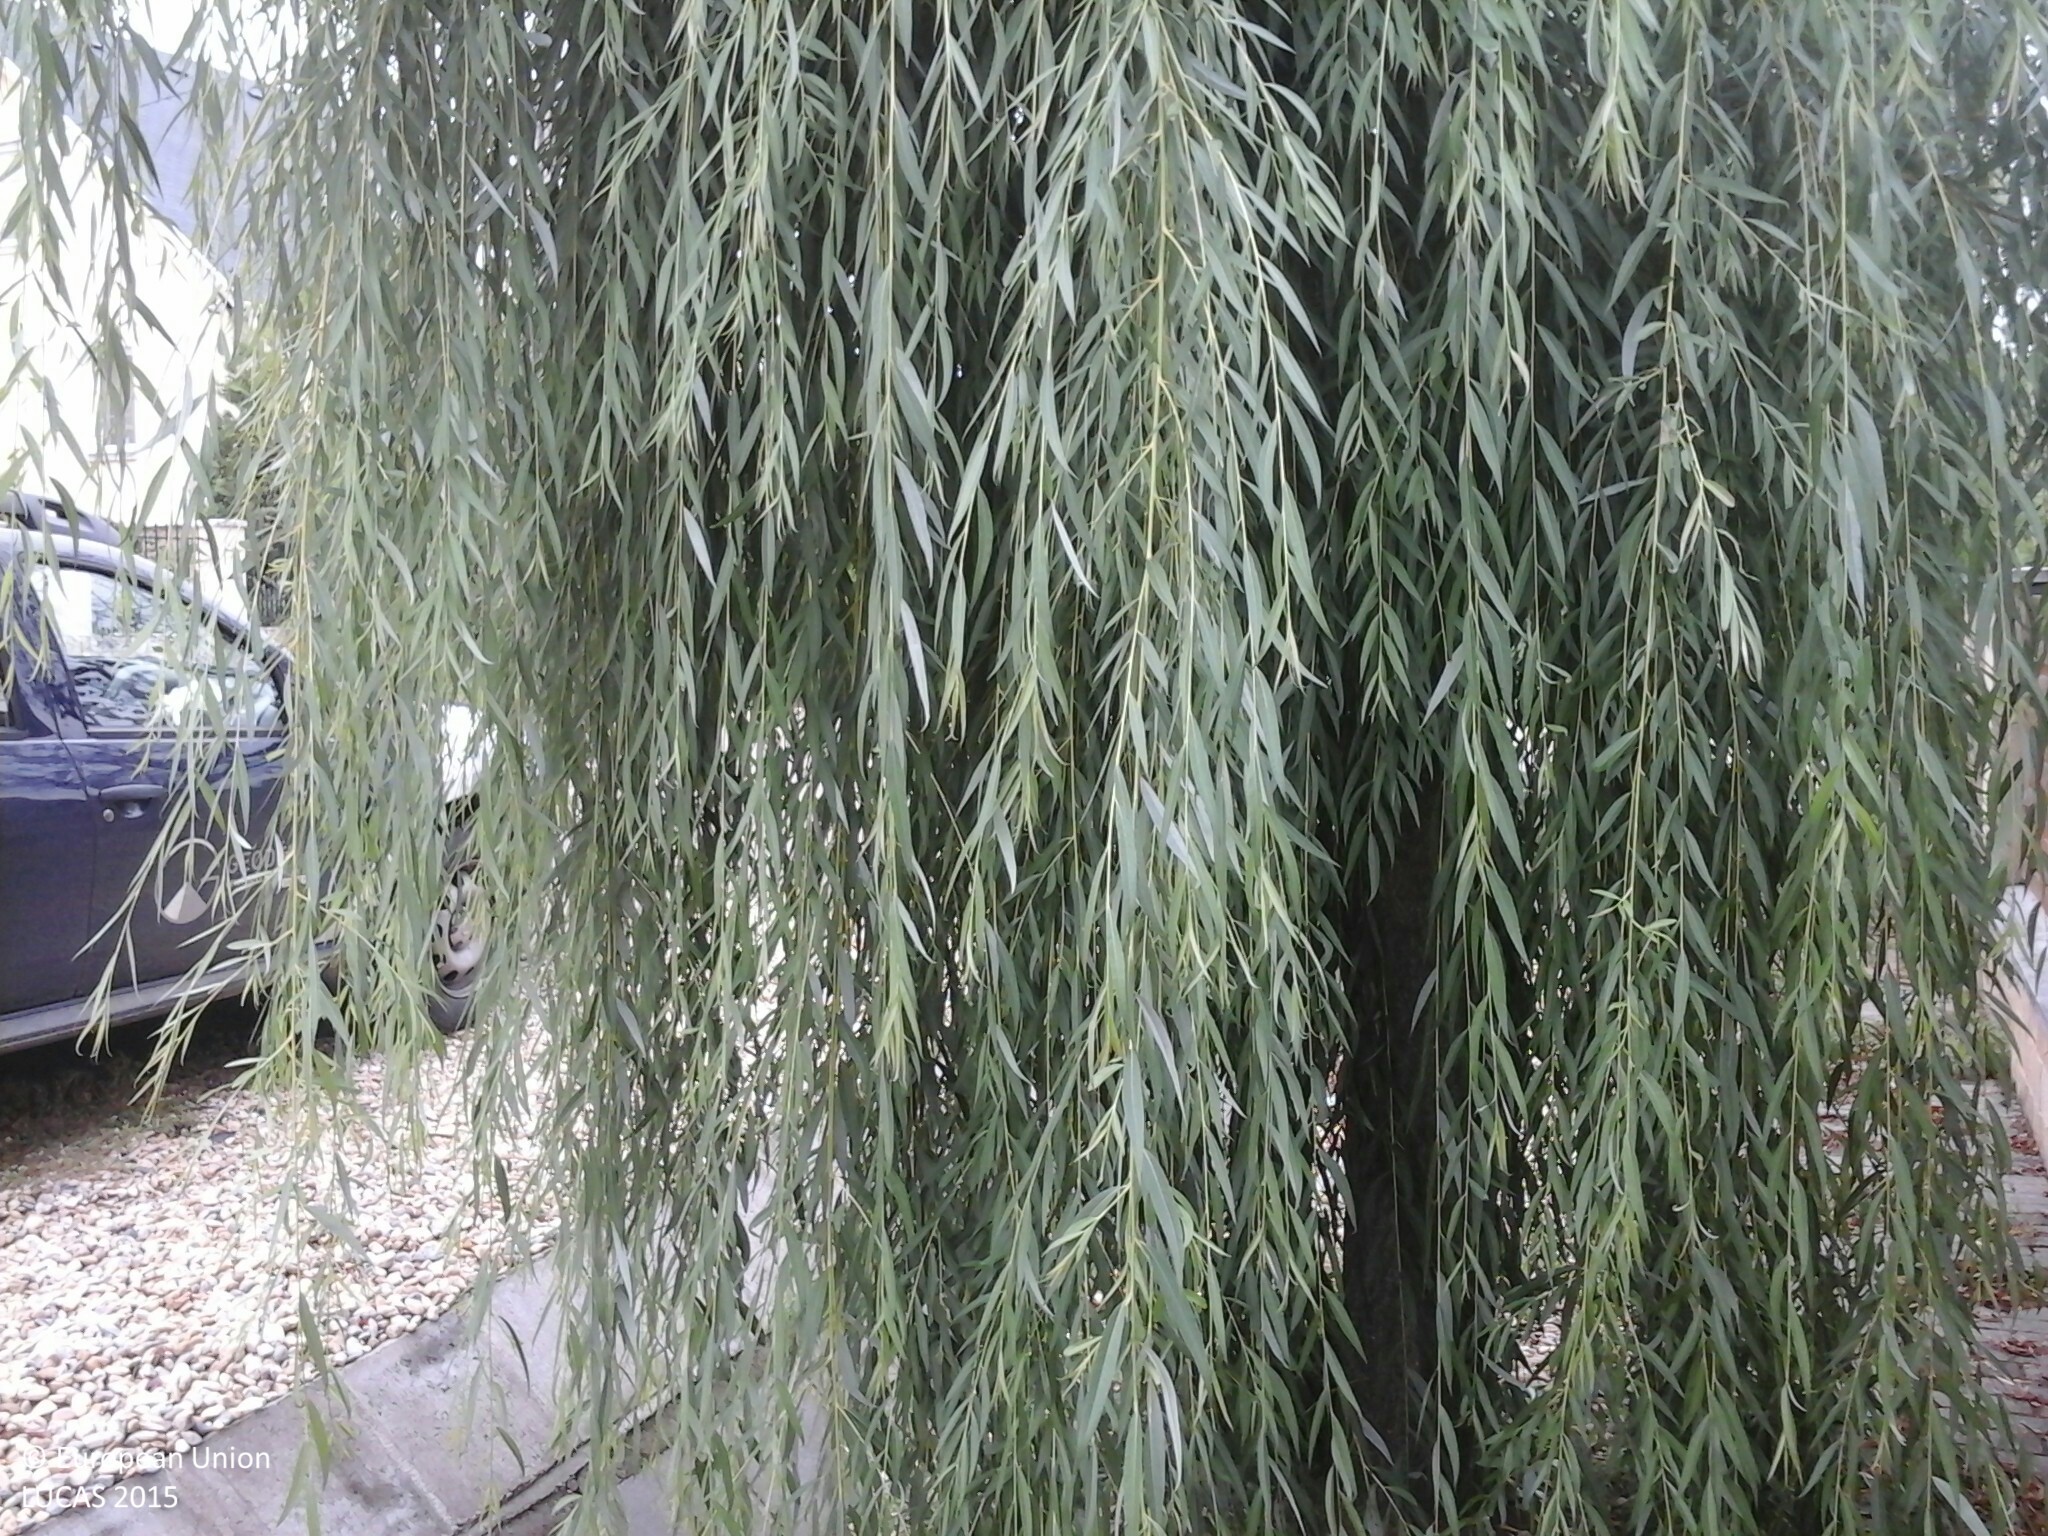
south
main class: Grassland
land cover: Grassland with sparse tree/shrub cover
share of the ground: > 75 %
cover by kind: herbaceous plants 85 %, shrubs 10 %, broadleaved forest trees 5 %
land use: Residential
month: July
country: HU
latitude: 47.9650
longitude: 20.4120
